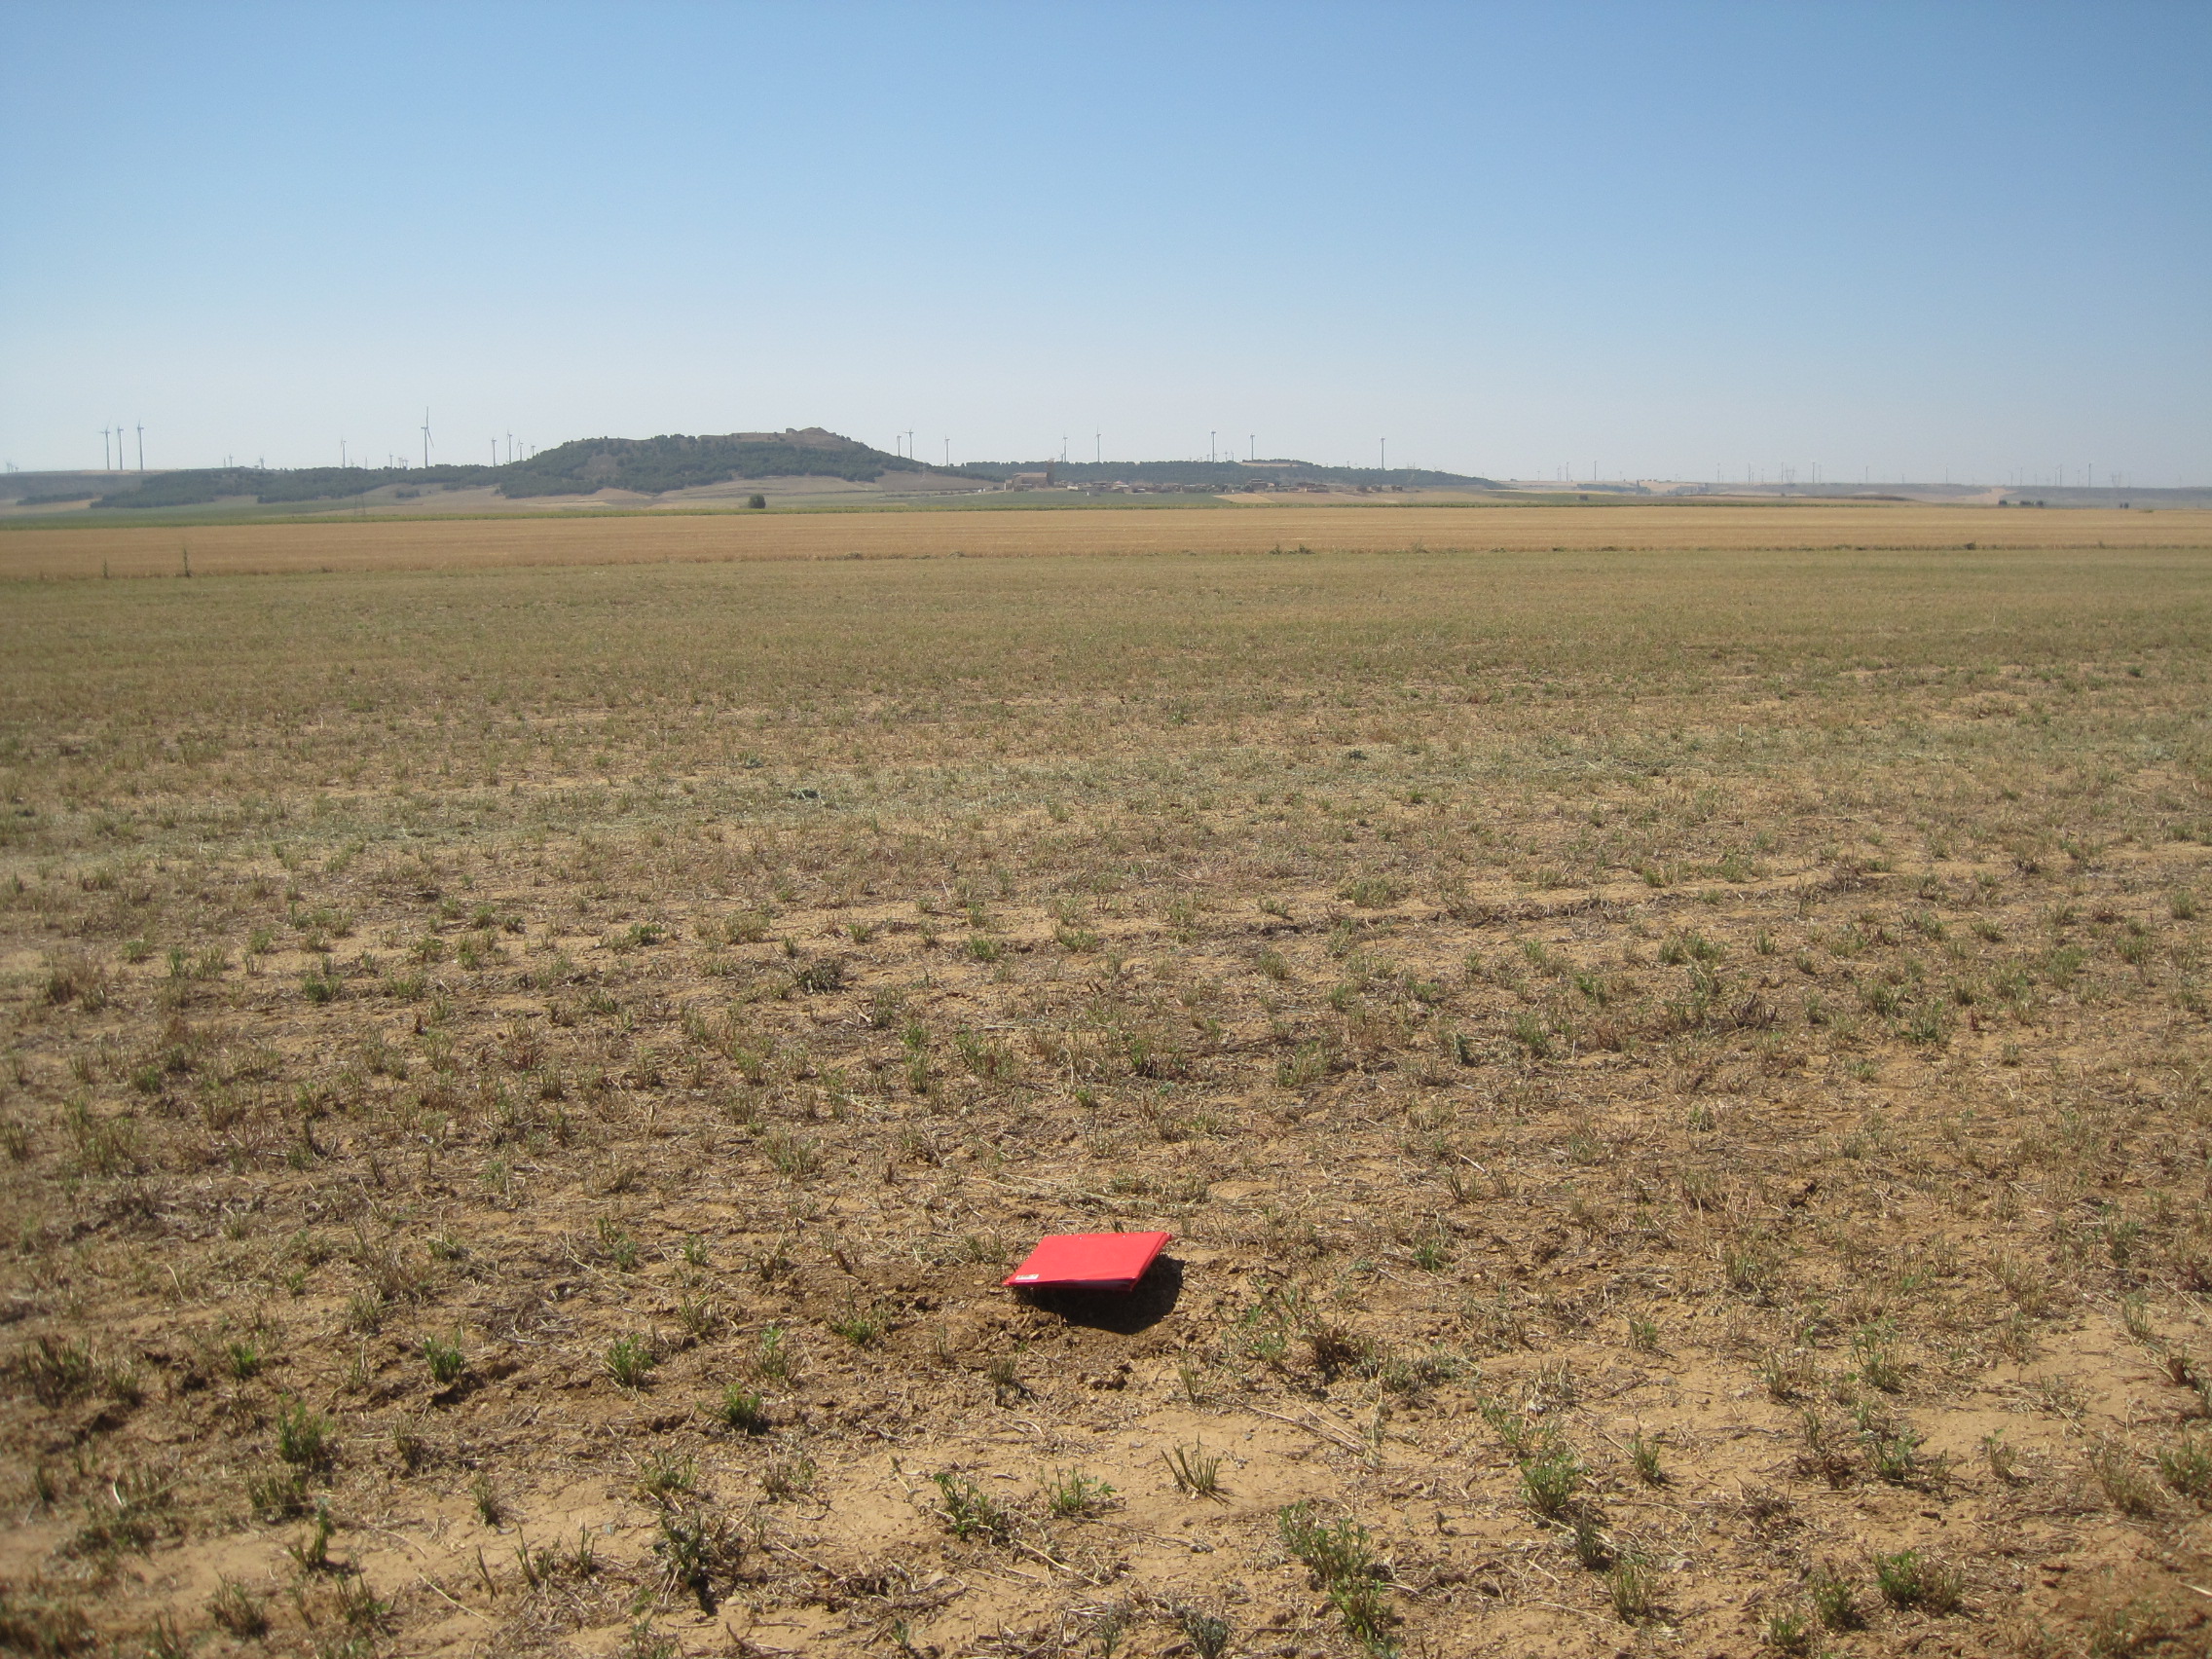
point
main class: Cropland
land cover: Lucerne
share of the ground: 10 - 25 %
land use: Agriculture (excluding fallow land and kitchen gardens)
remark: Harvested field
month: July
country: ES
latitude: 41.9834
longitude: -4.7873
